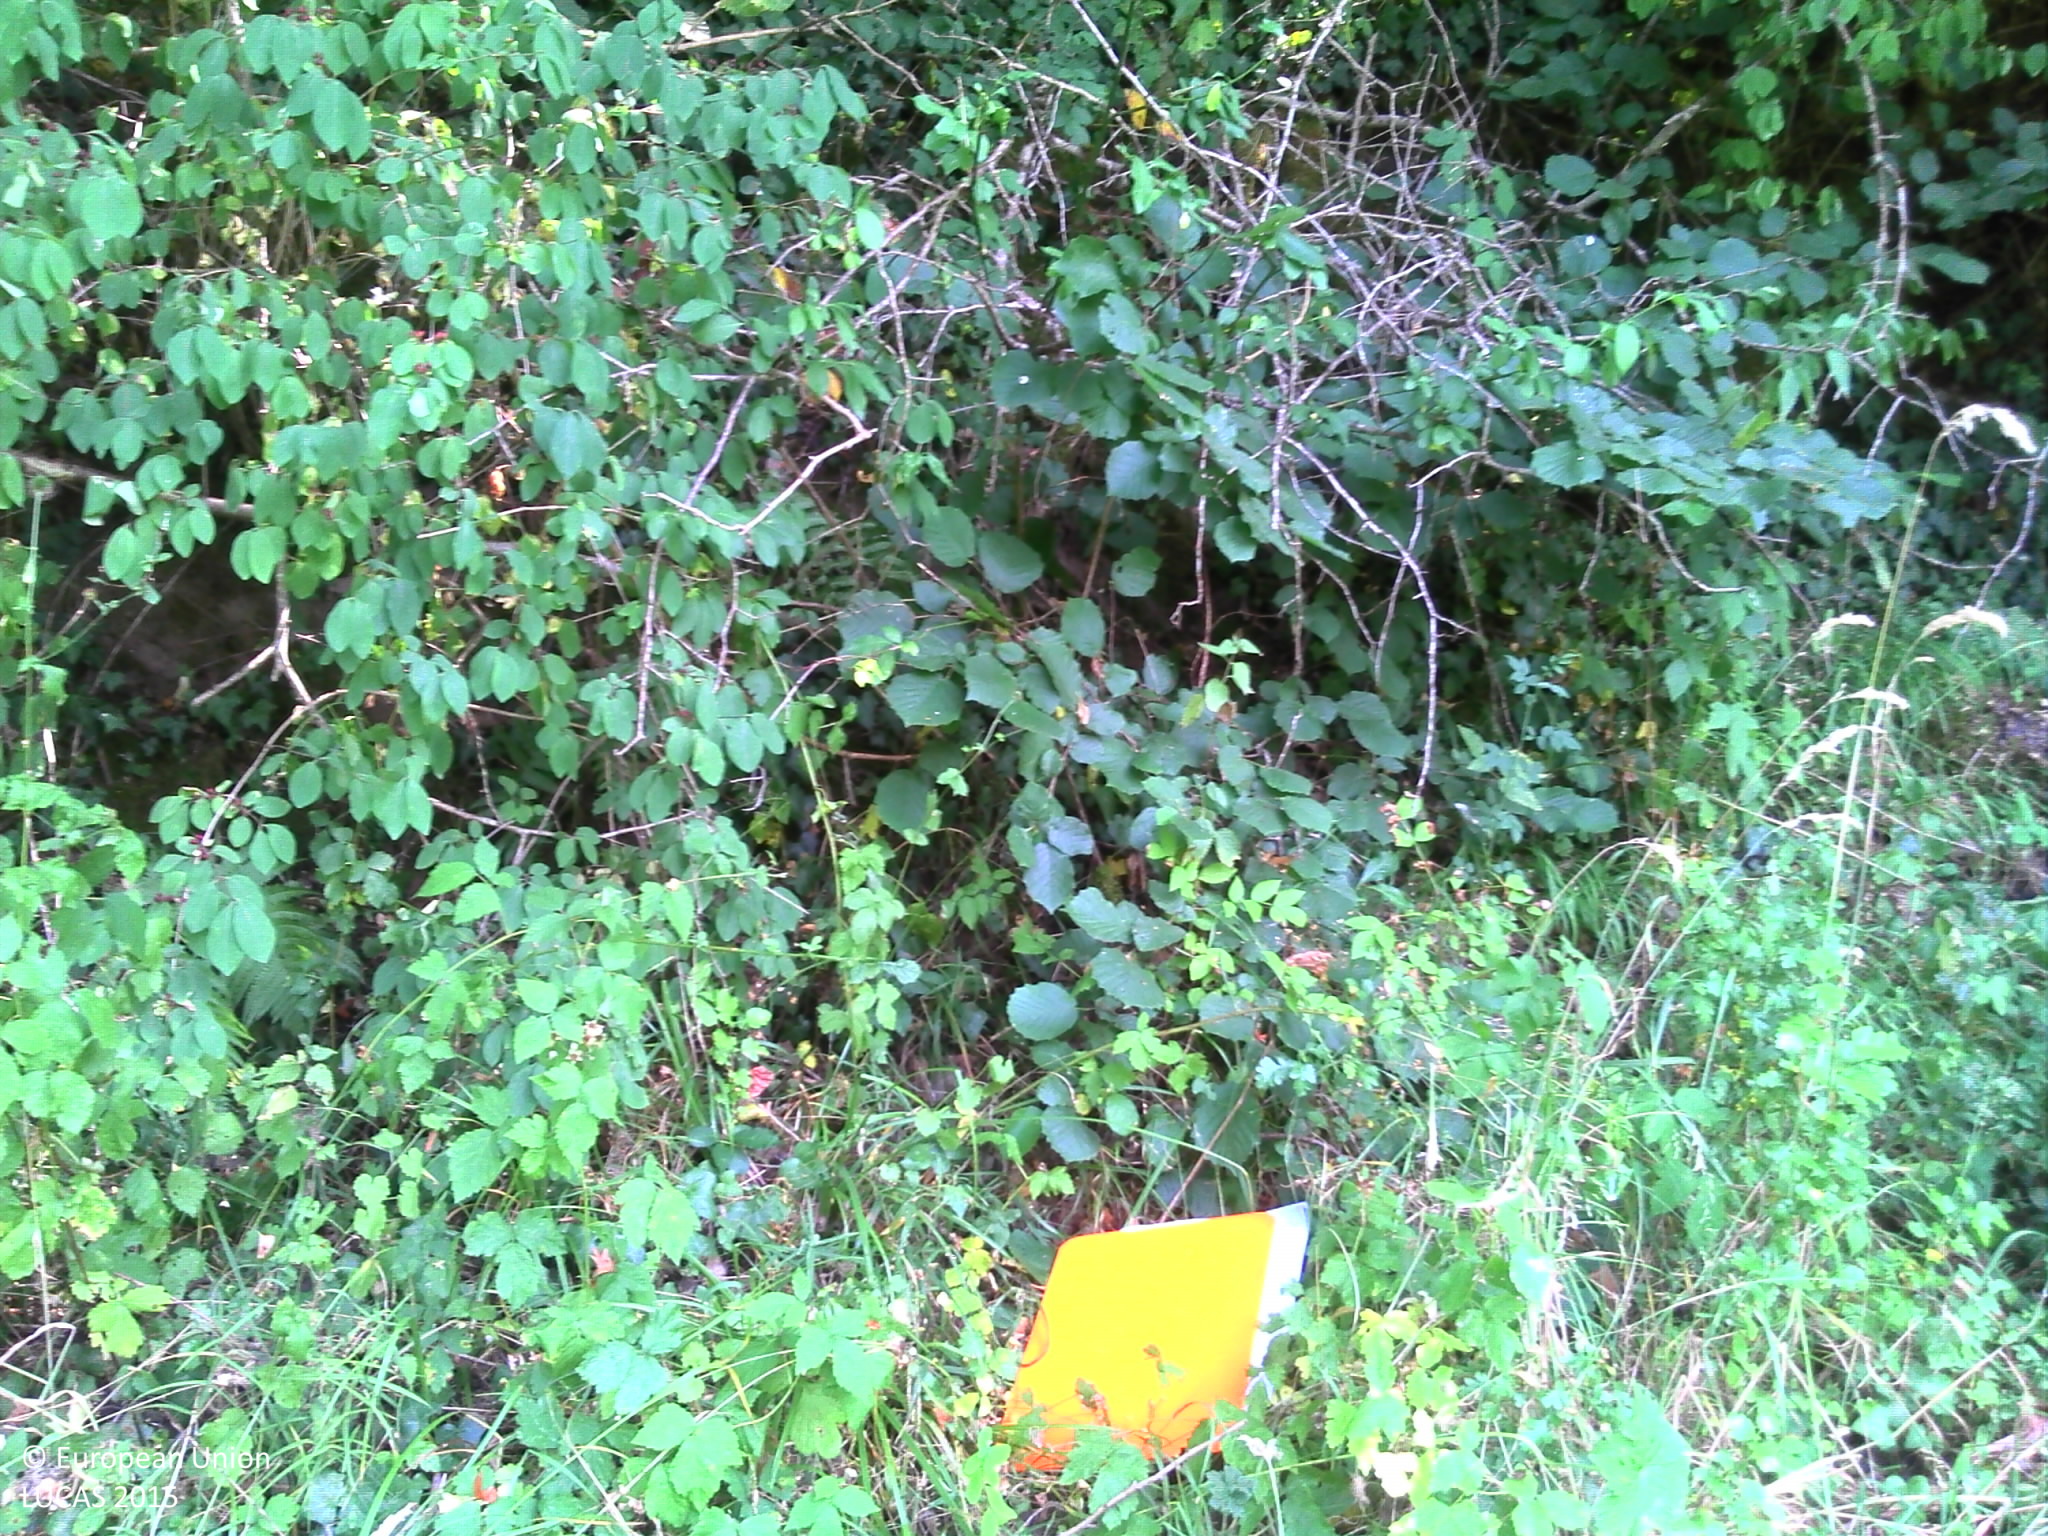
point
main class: Woodland
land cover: Broadleaved woodland
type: mesophytic deciduous forest
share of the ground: > 75 %
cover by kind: broadleaved forest trees 100 %
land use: Forestry
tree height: > 5 m
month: July
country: FR
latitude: 45.2855
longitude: 3.2063
